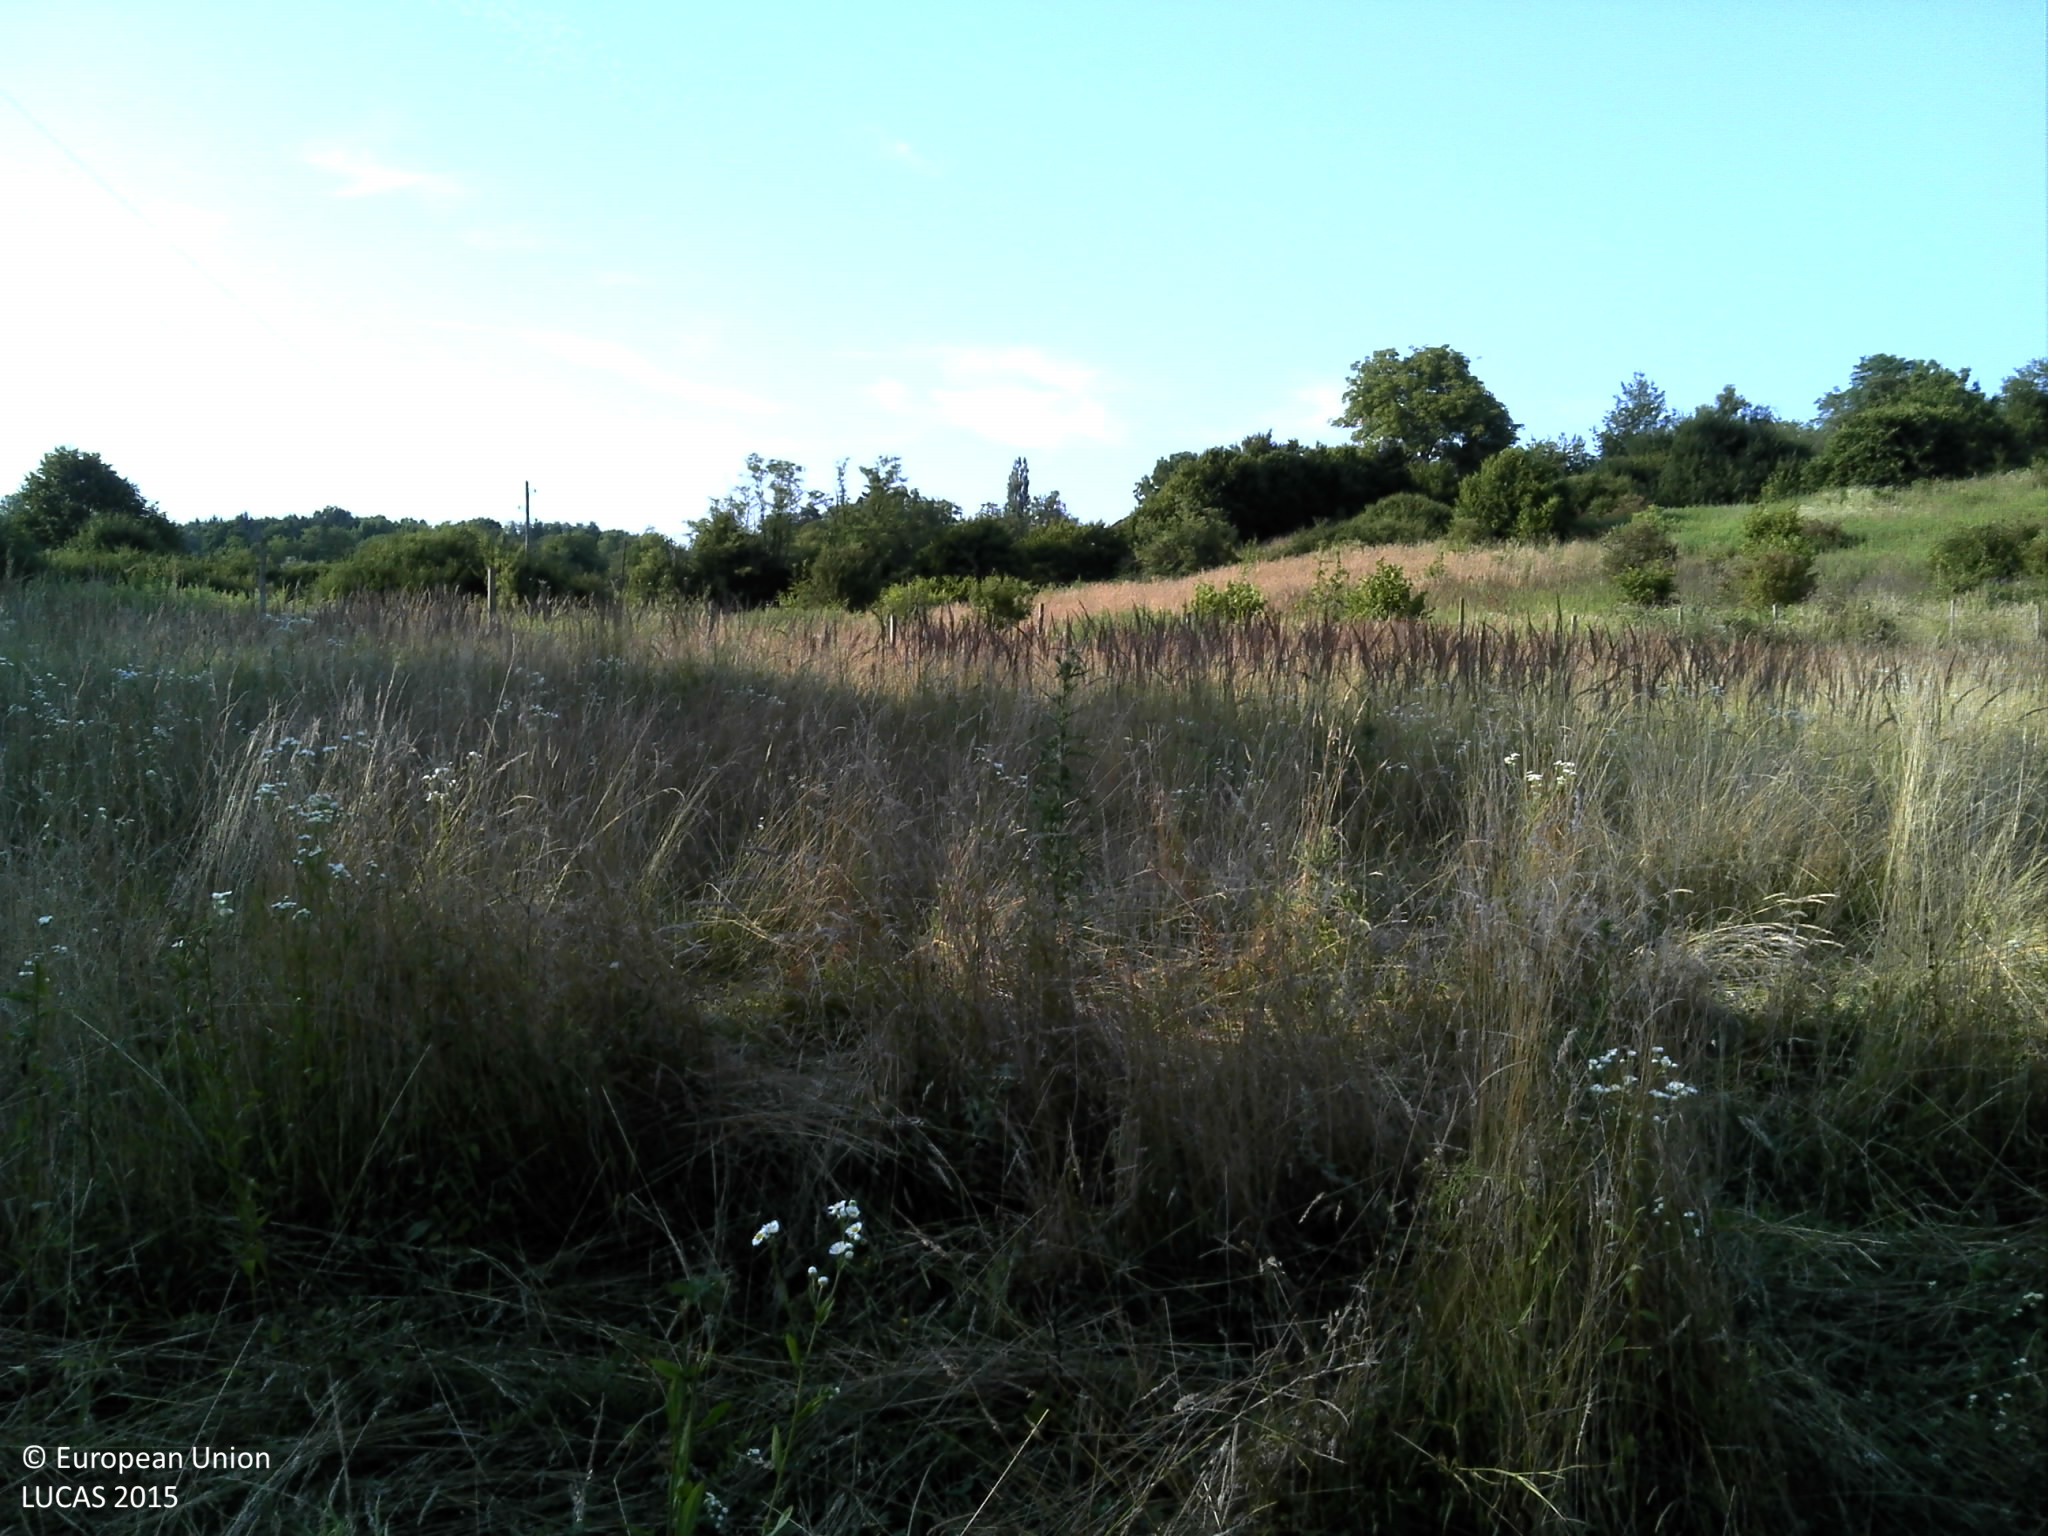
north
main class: Grassland
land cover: Grassland without tree/shrub cover
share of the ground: > 75 %
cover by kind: herbaceous plants 100 %
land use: Semi-natural and natural areas not in use
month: July
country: HR
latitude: 45.5431
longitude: 16.7229
